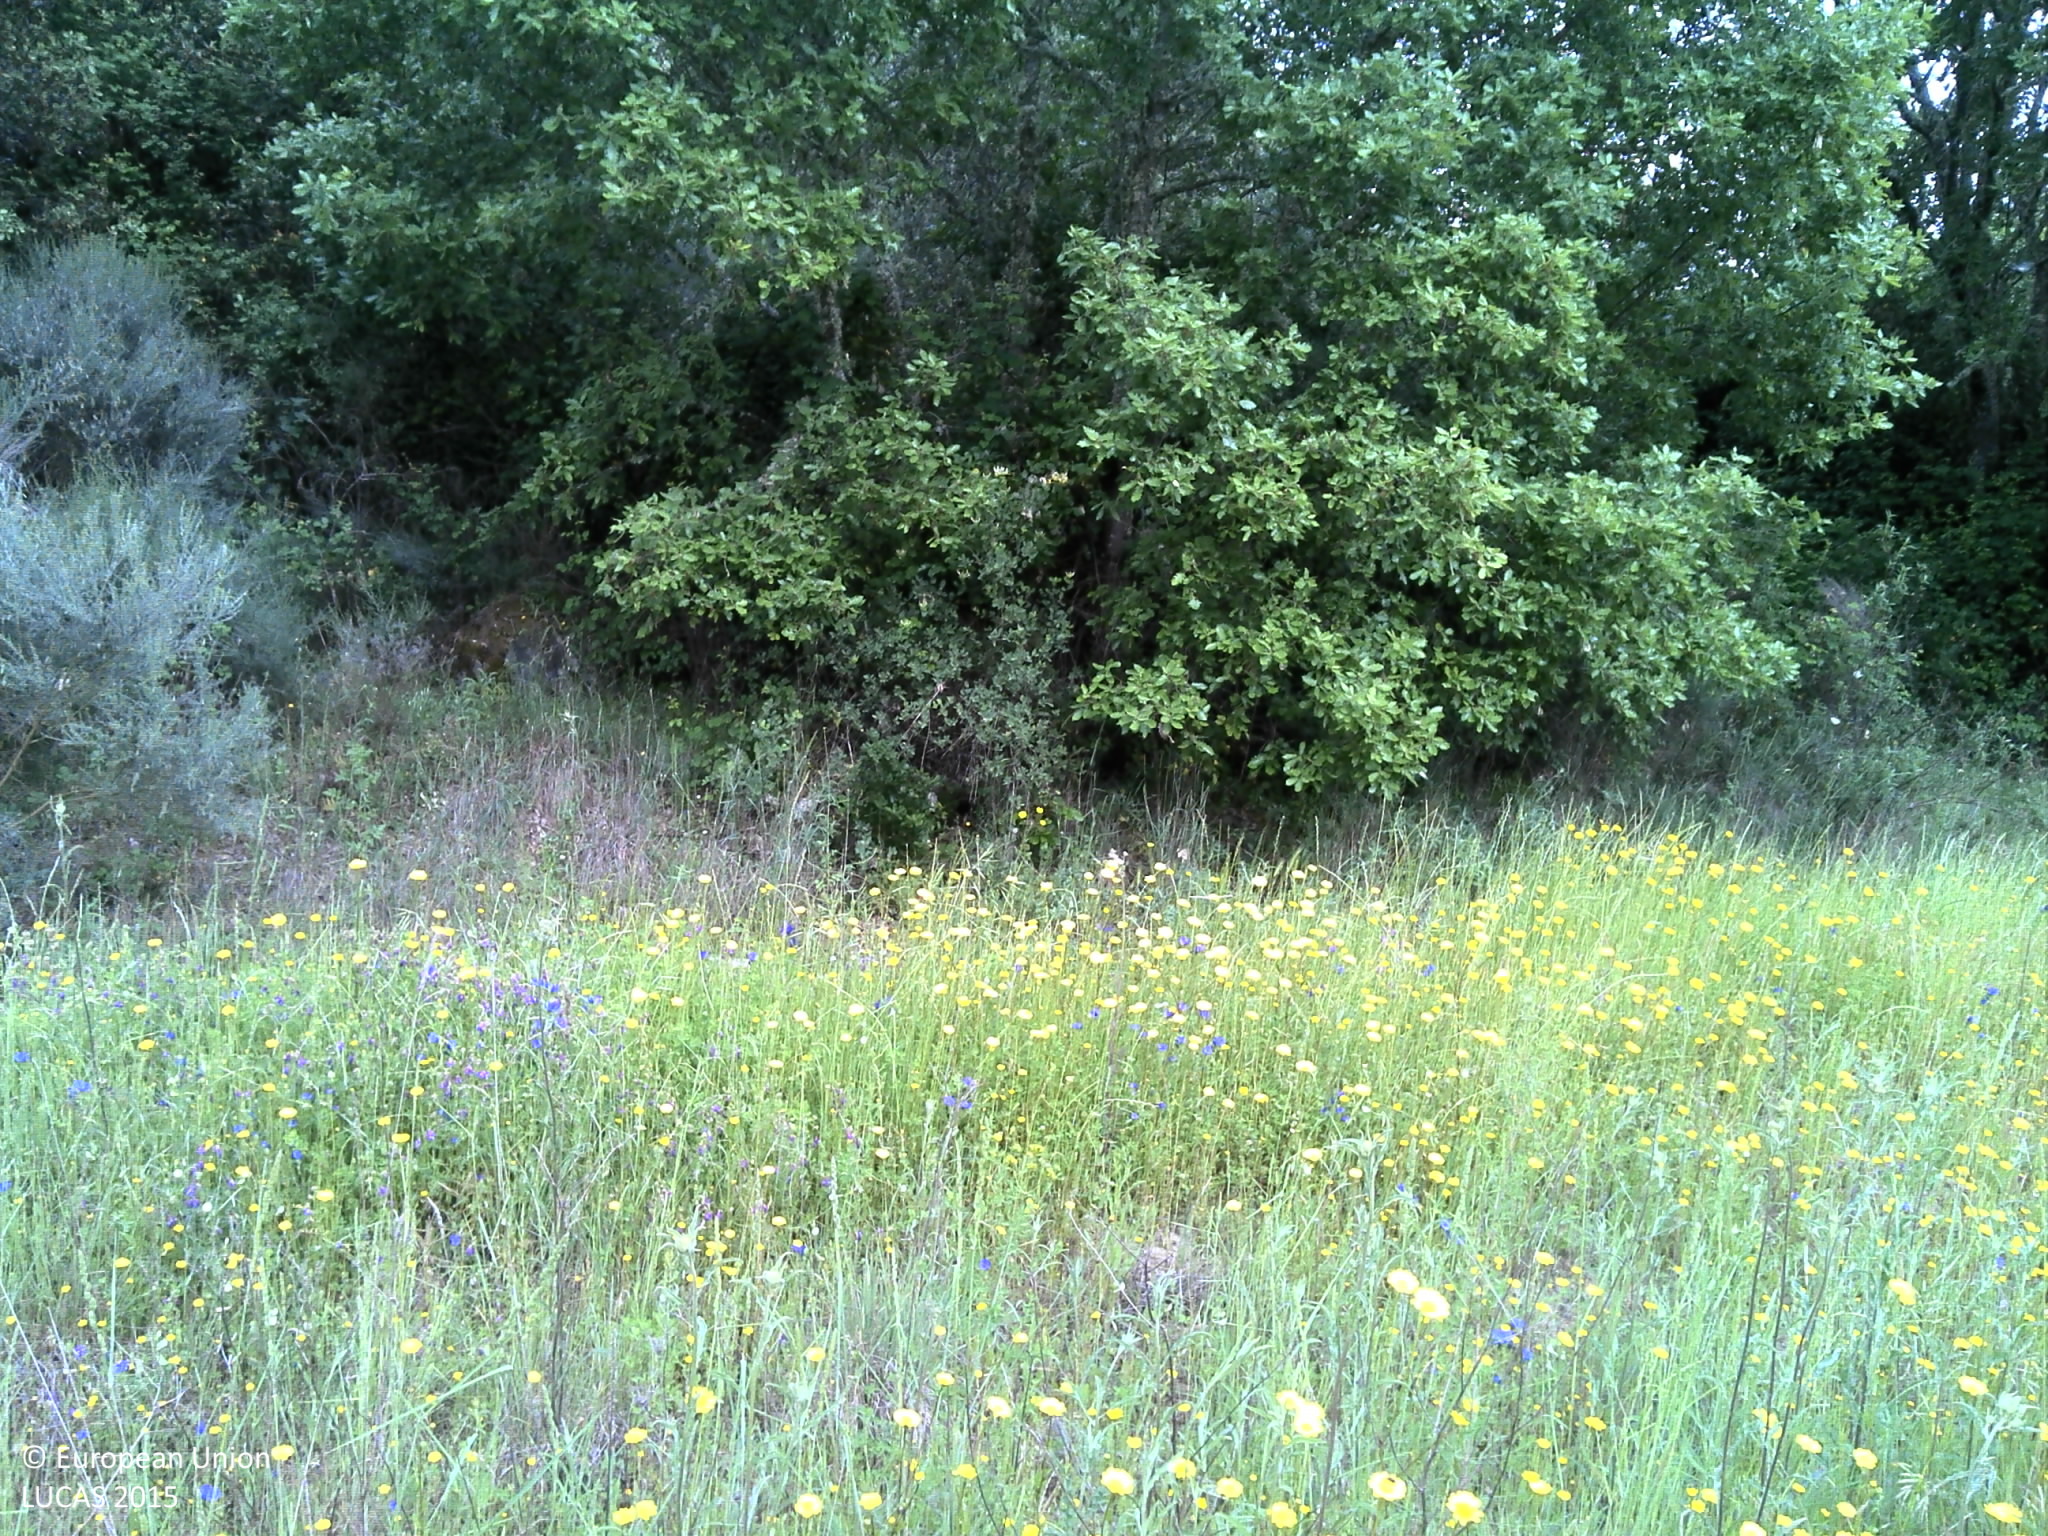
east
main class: Woodland
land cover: Broadleaved woodland
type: exotic forest
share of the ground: 10 - 25 %
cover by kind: herbaceous plants 70 %, broadleaved forest trees 20 %, unconsolidated bare surface 10 %
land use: Forestry
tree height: < 5 m
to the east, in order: Broadleaved woodland; Grassland without tree/shrub cover; Broadleaved woodland; Grassland with sparse tree/shrub cover; Tracks; Broadleaved woodland; Pine dominated coniferous woodland; Shrubland with sparse tree cover; Tracks; Grassland with sparse tree/shrub cover; Broadleaved woodland; Spontaneously vegetated surfaces
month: May
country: PT
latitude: 41.6380
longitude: -7.1556
